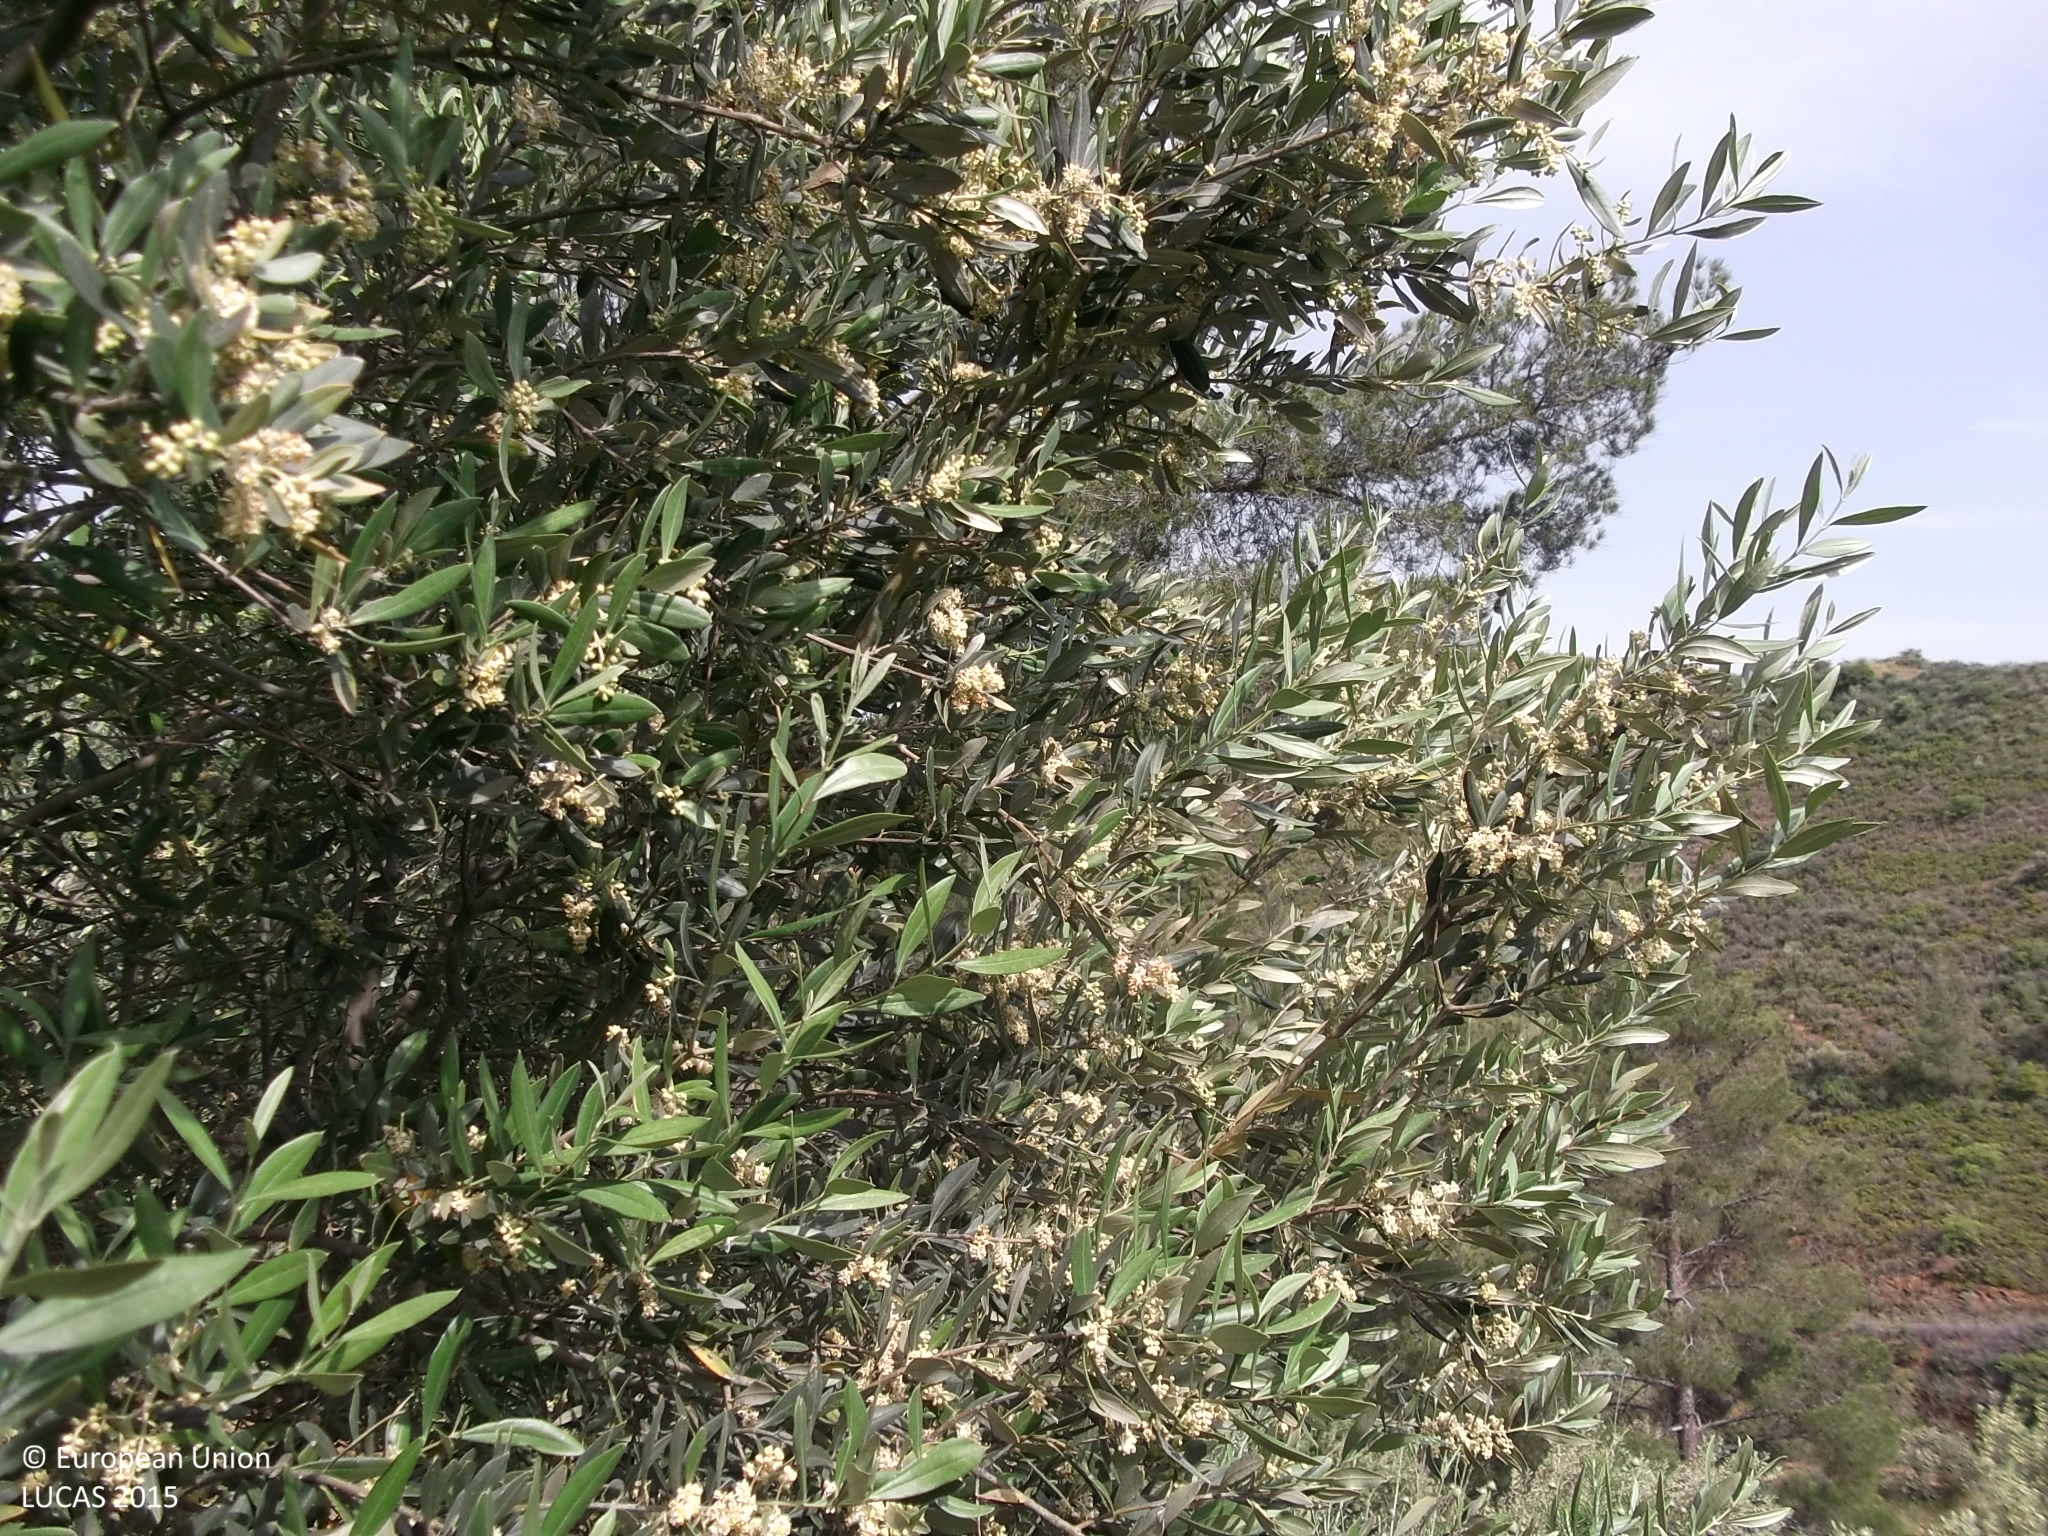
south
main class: Cropland
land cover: Olive groves
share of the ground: 50 - 75 %
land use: Agriculture (excluding fallow land and kitchen gardens)
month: April
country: CY
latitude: 34.8605
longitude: 33.1793
